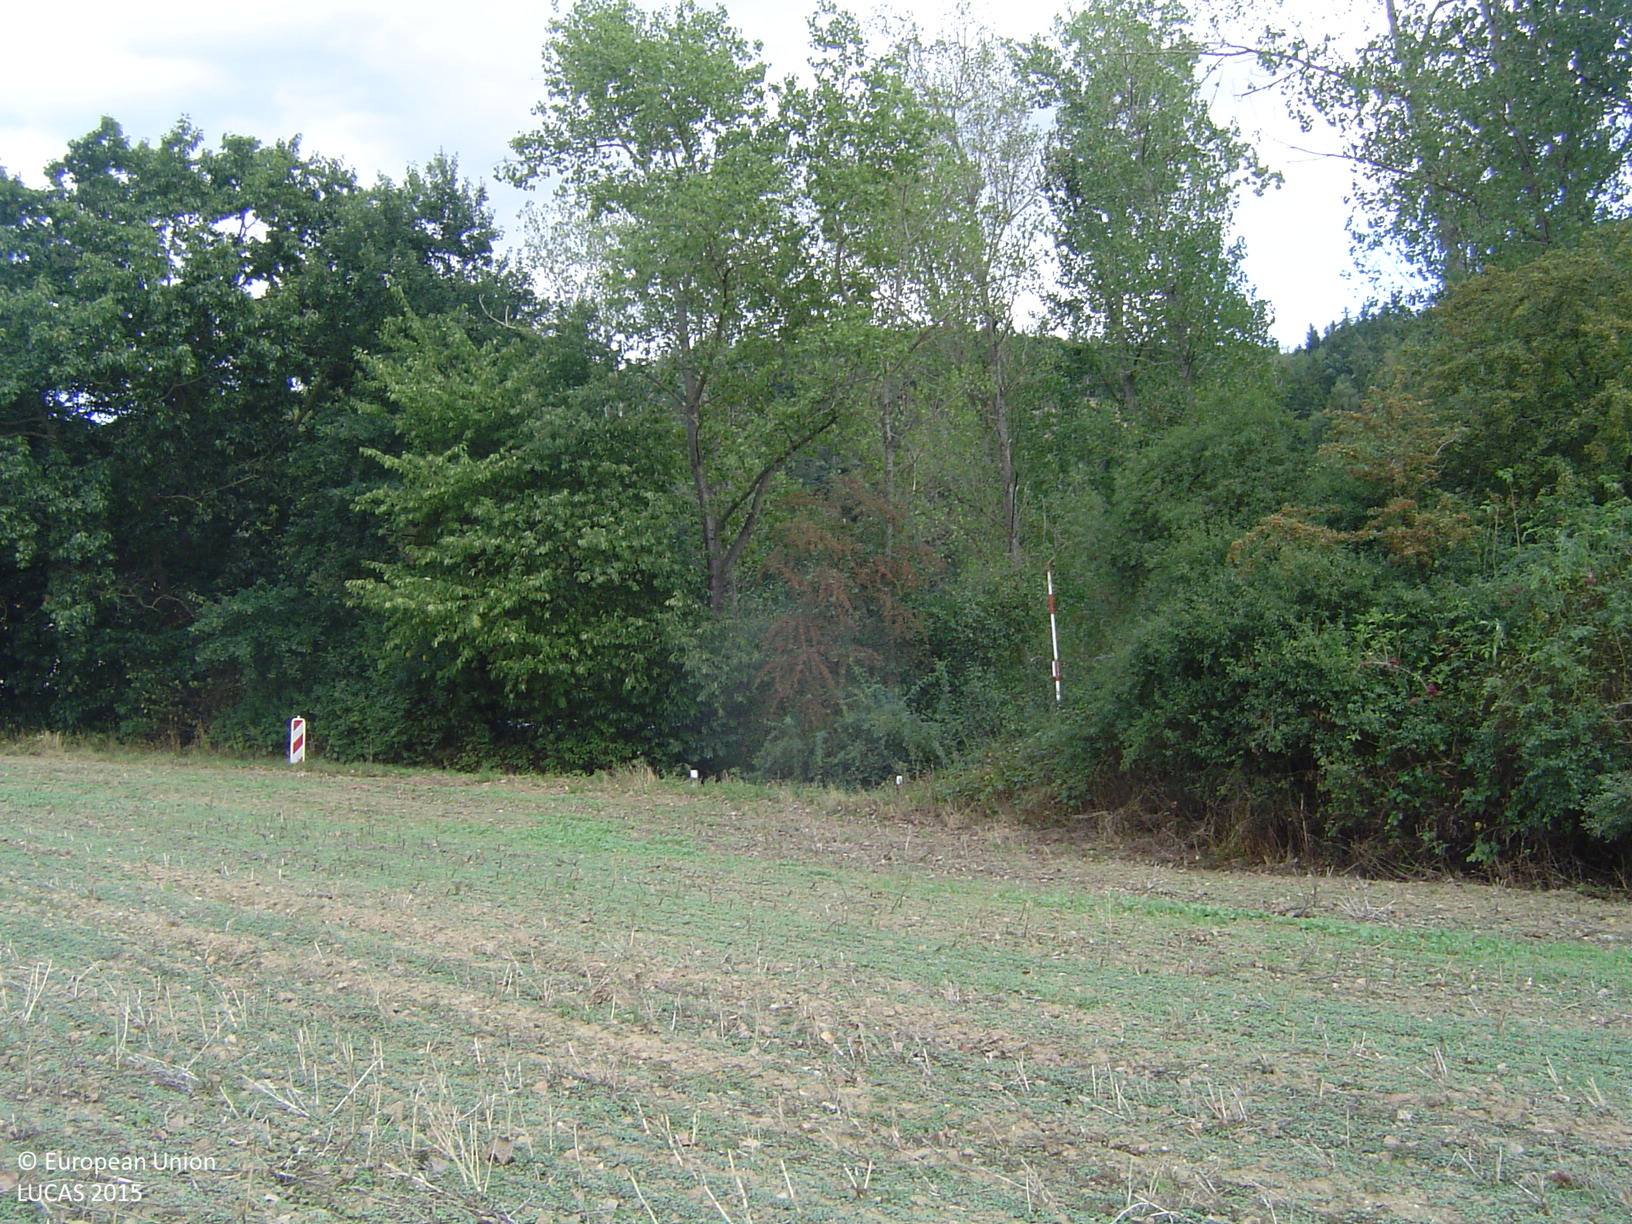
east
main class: Cropland
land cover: Rape and turnip rape
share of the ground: < 10 %
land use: Agriculture (excluding fallow land and kitchen gardens)
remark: Harvested field
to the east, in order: Rape and turnip rape; Tracks; Fences; Broadleaved woodland; Artificial constructions in urban areas; Inland fresh running water
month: August
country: CZ
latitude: 49.7065
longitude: 14.3138
